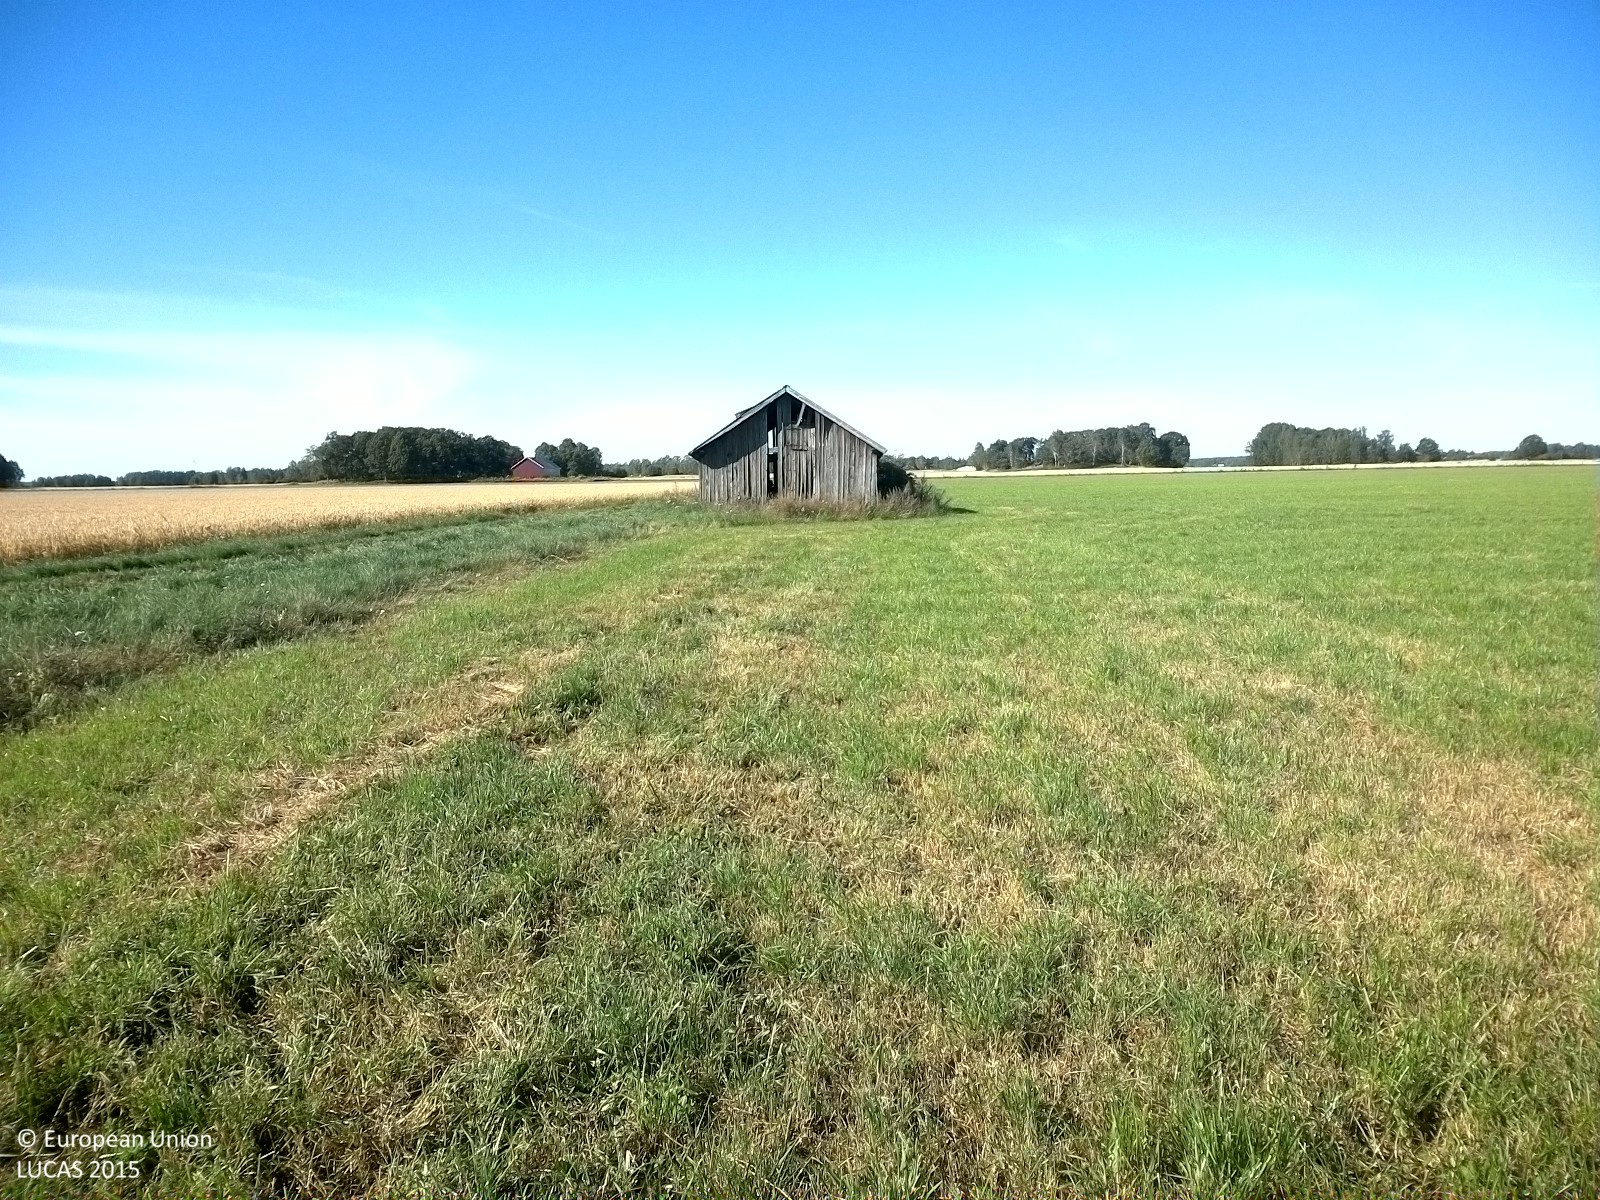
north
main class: Cropland
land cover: Temporary grasslands
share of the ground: > 75 %
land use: Agriculture (excluding fallow land and kitchen gardens)
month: August
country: SE
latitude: 59.1711
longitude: 15.5029
